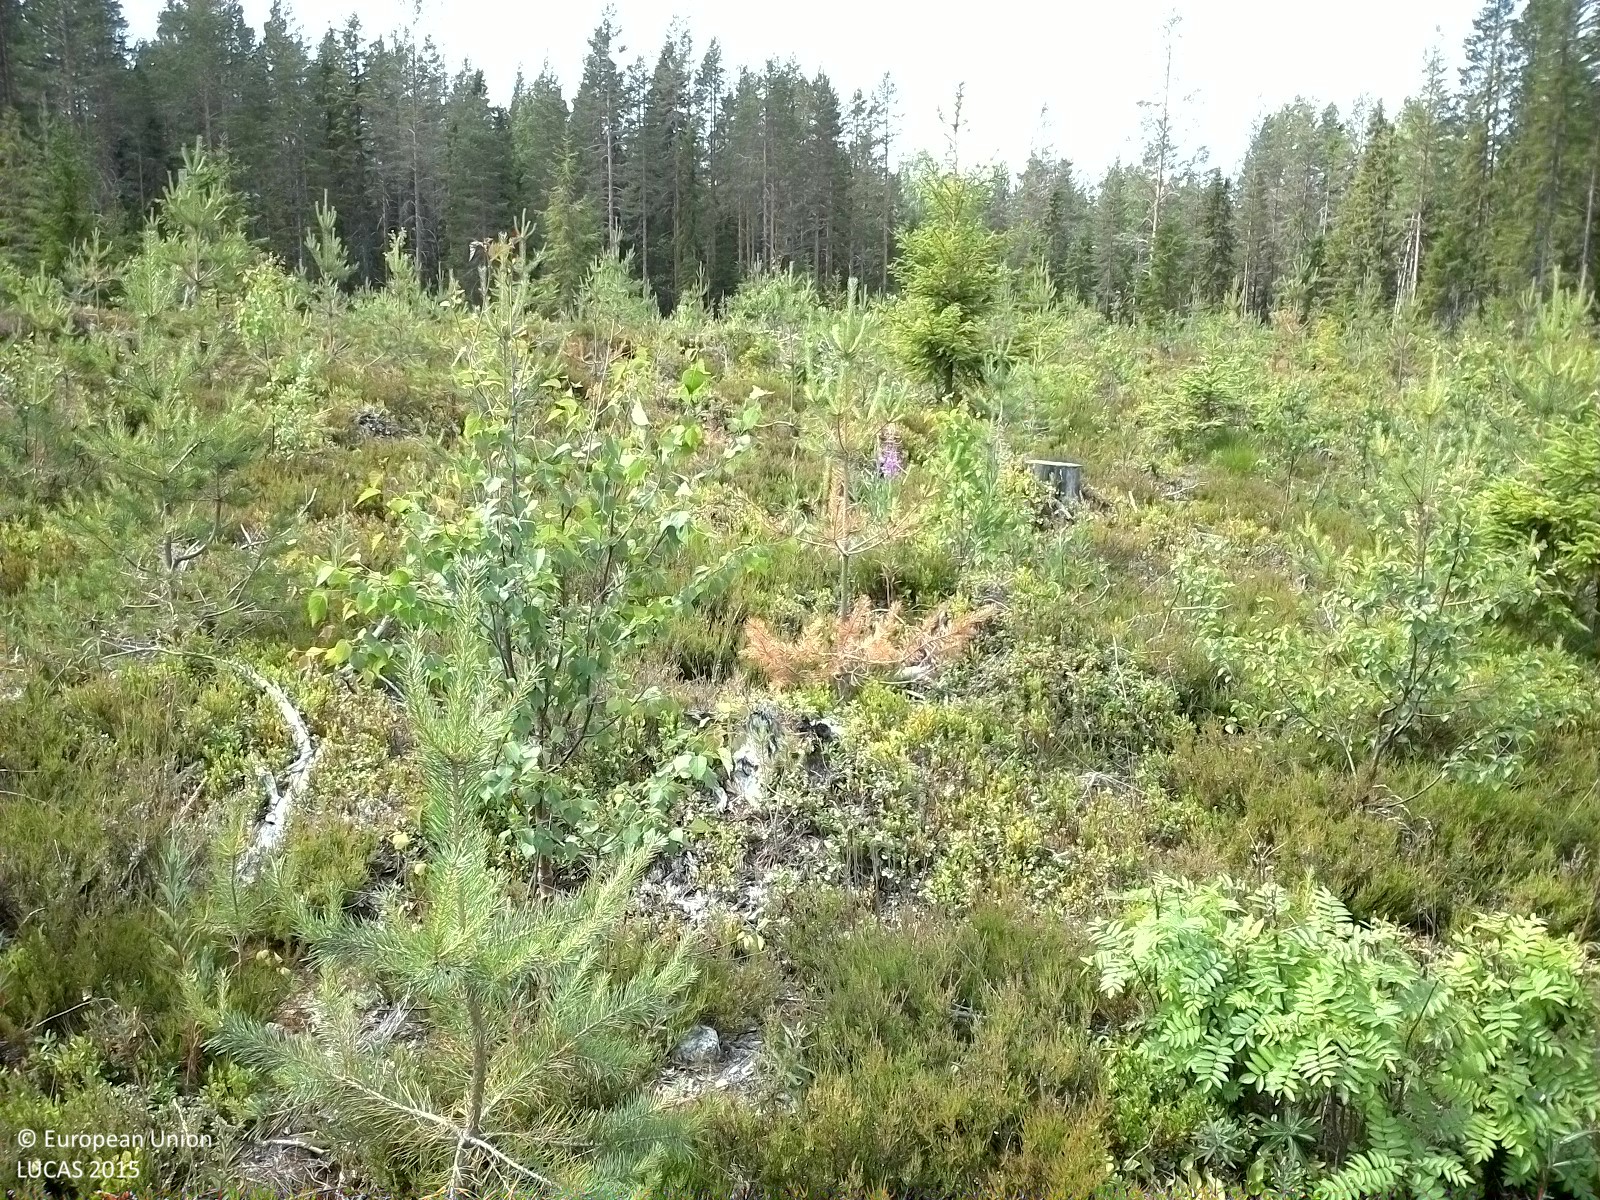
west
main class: Woodland
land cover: Pine dominated mixed woodland
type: boreal forest
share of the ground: 25 - 50 %
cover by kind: shrubs 65 %, coniferous forest trees 25 %, broadleaved forest trees 10 %
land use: Forestry
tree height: < 5 m
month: July
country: SE
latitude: 62.1335
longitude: 17.1733
